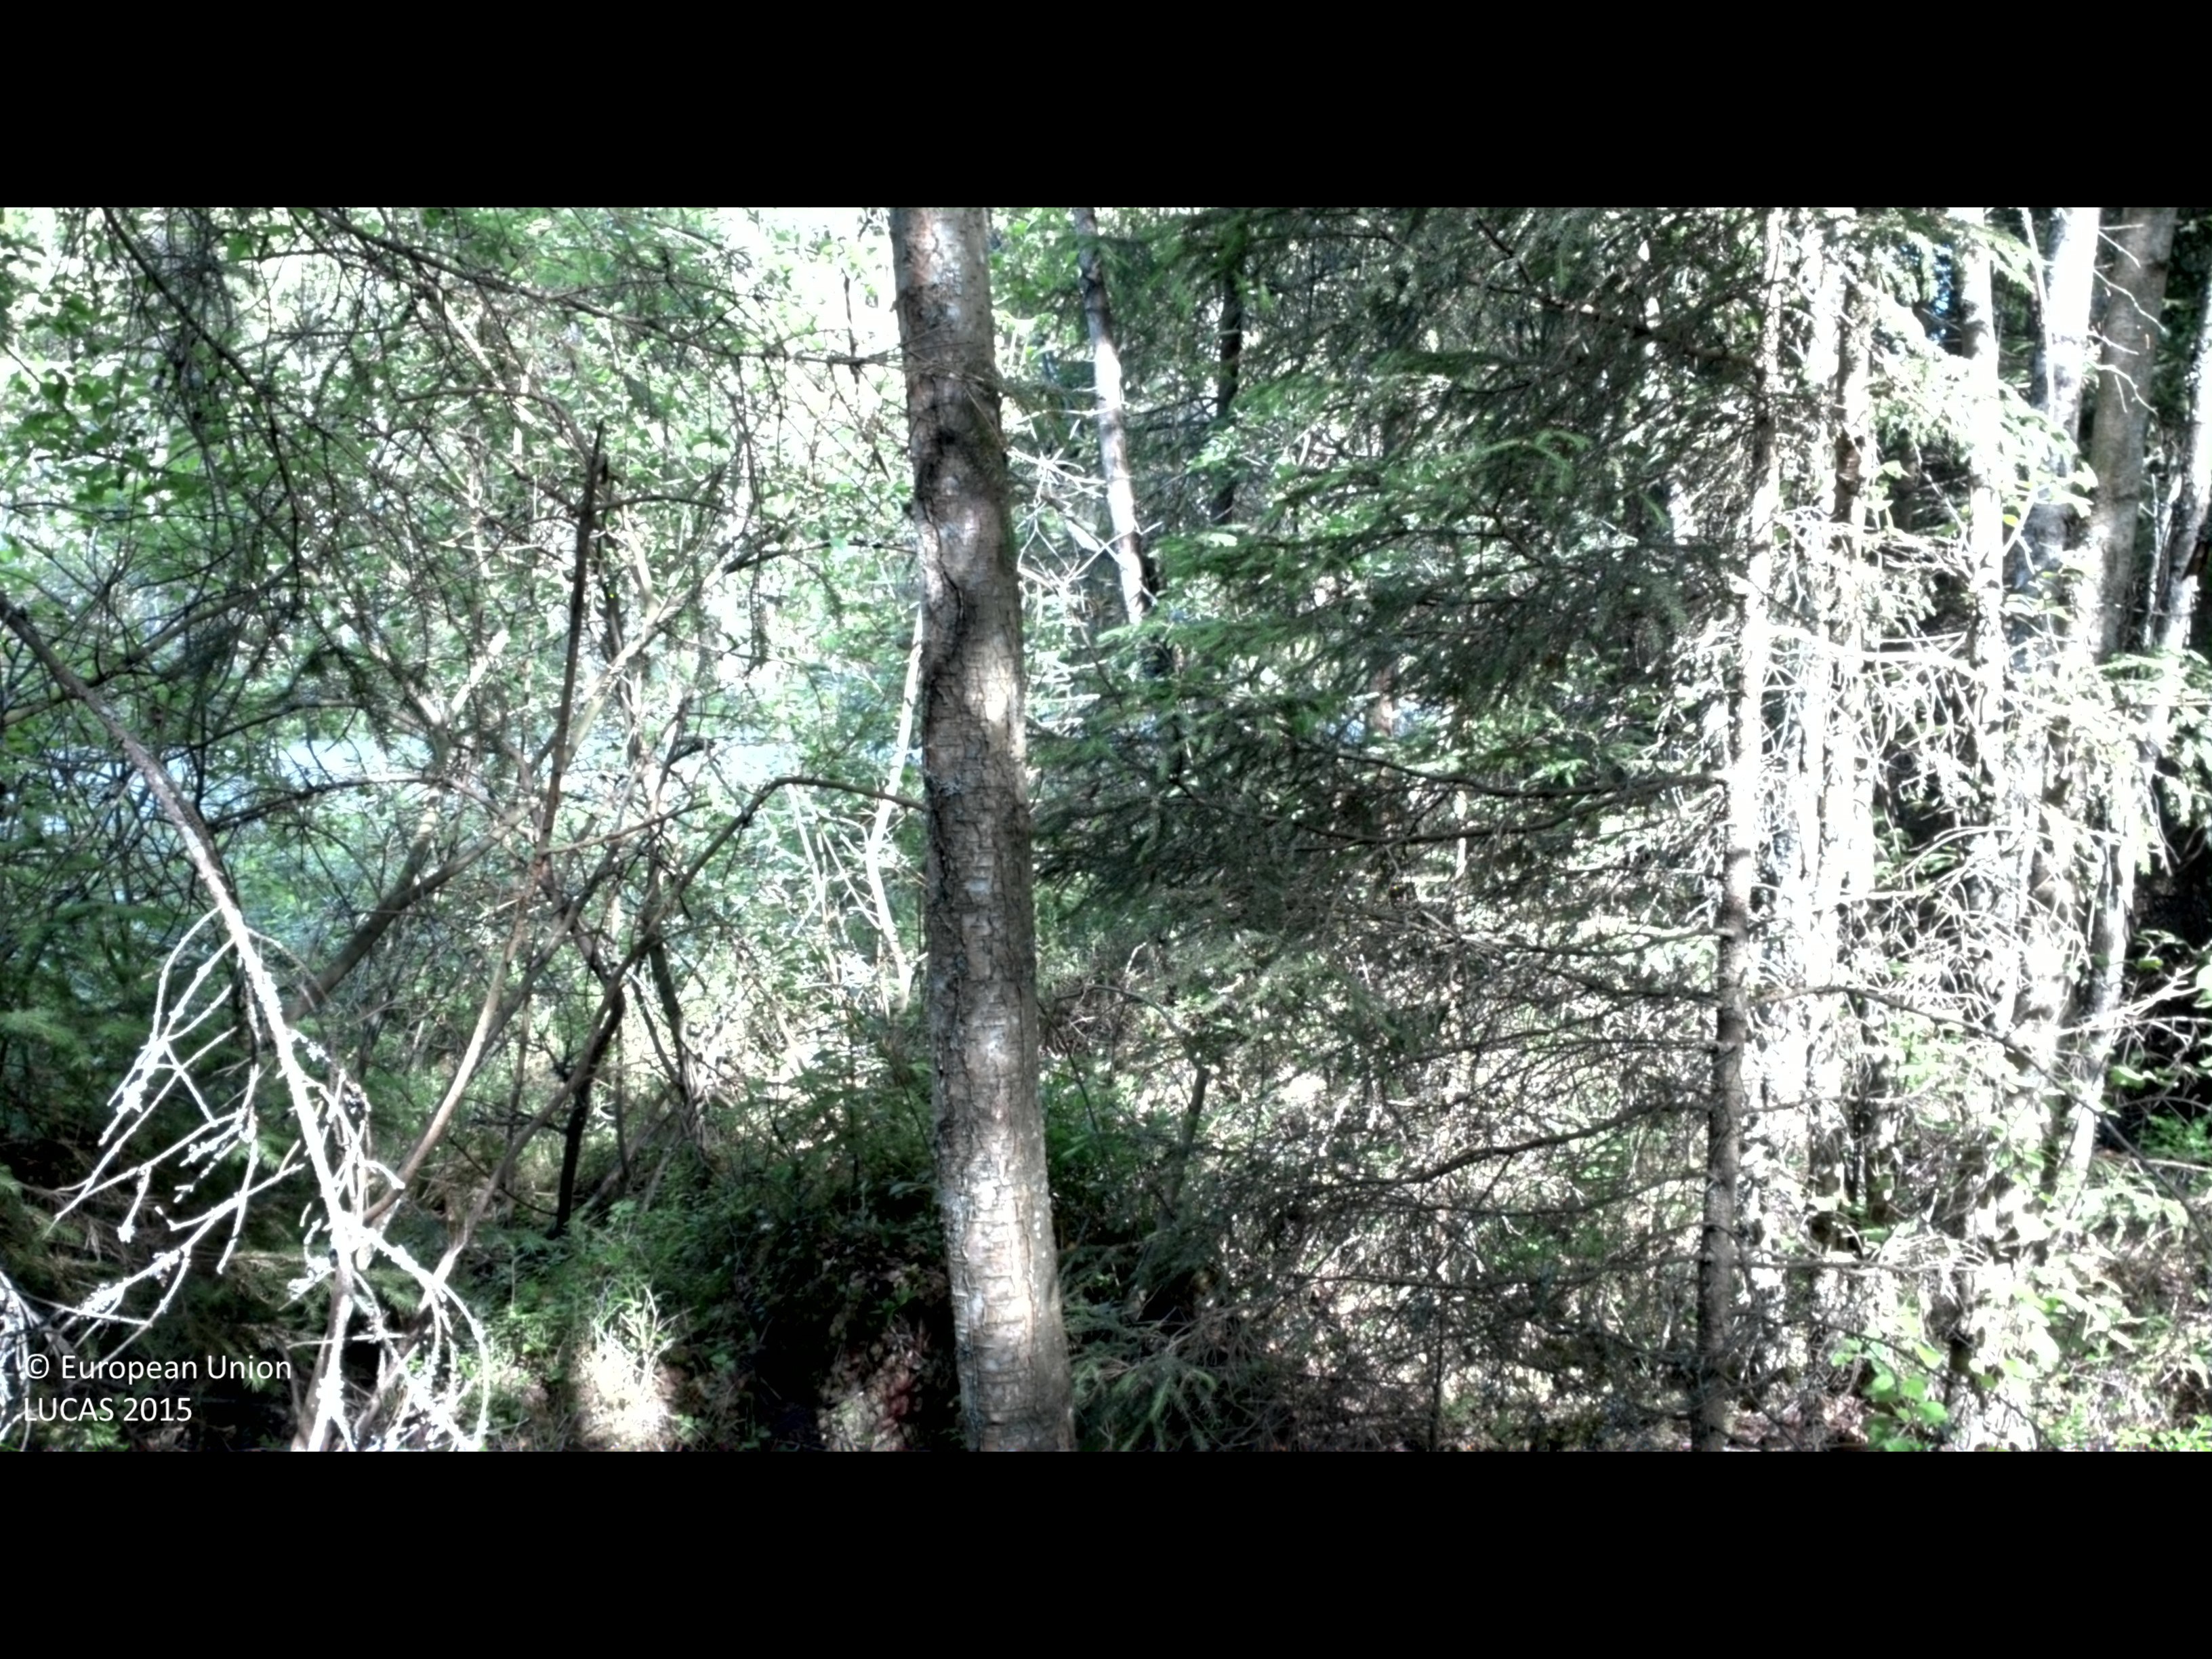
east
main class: Woodland
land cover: Spruce dominated coniferous woodland
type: boreal forest
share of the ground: 50 - 75 %
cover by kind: coniferous forest trees 55 %, shrubs 25 %, broadleaved forest trees 15 %, lichens and mosses 5 %
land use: Forestry
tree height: > 5 m
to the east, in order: Spruce dominated coniferous woodland; Paved roads, cycling and walking lanes; Electric lines; Spruce dominated coniferous woodland; Tracks; Other mixed woodland; Spruce dominated mixed woodland; Pine dominated mixed woodland; Pine dominated coniferous woodland
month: July
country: SE
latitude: 56.4580
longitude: 14.2976
